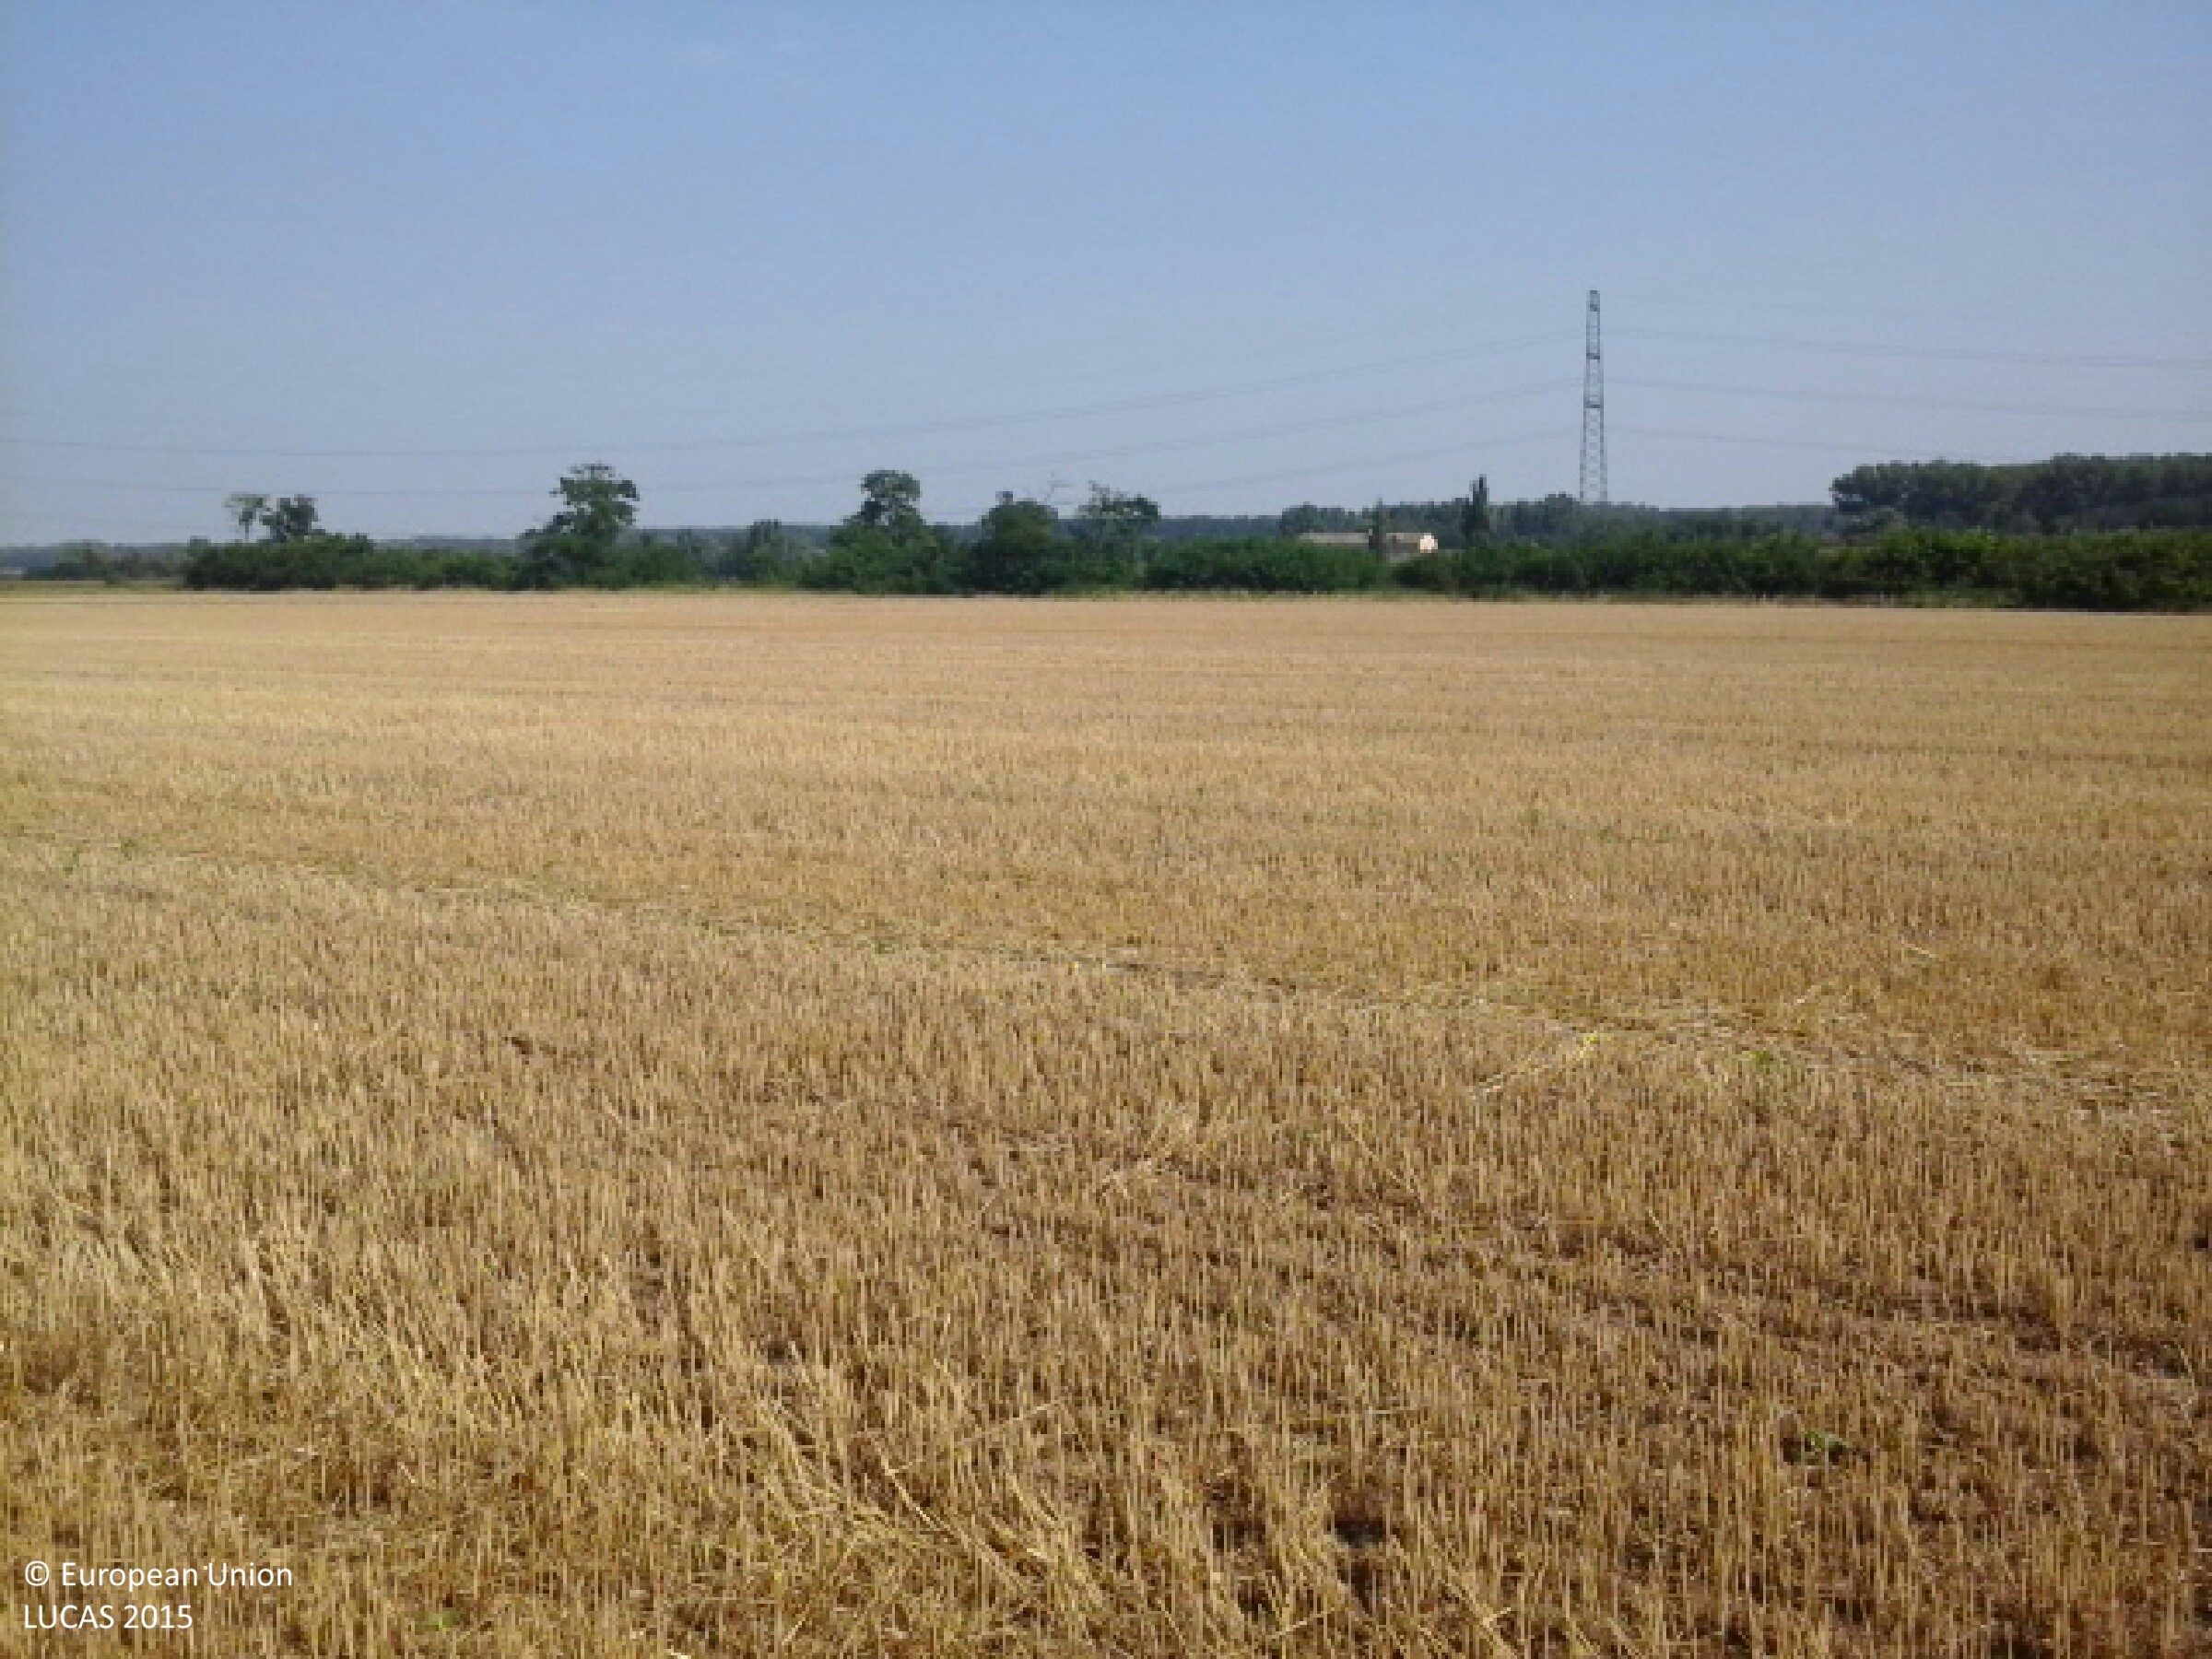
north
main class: Cropland
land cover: Triticale
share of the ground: 10 - 25 %
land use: Agriculture (excluding fallow land and kitchen gardens)
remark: Harvested field
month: August
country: HU
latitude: 47.5451
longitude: 18.1030
